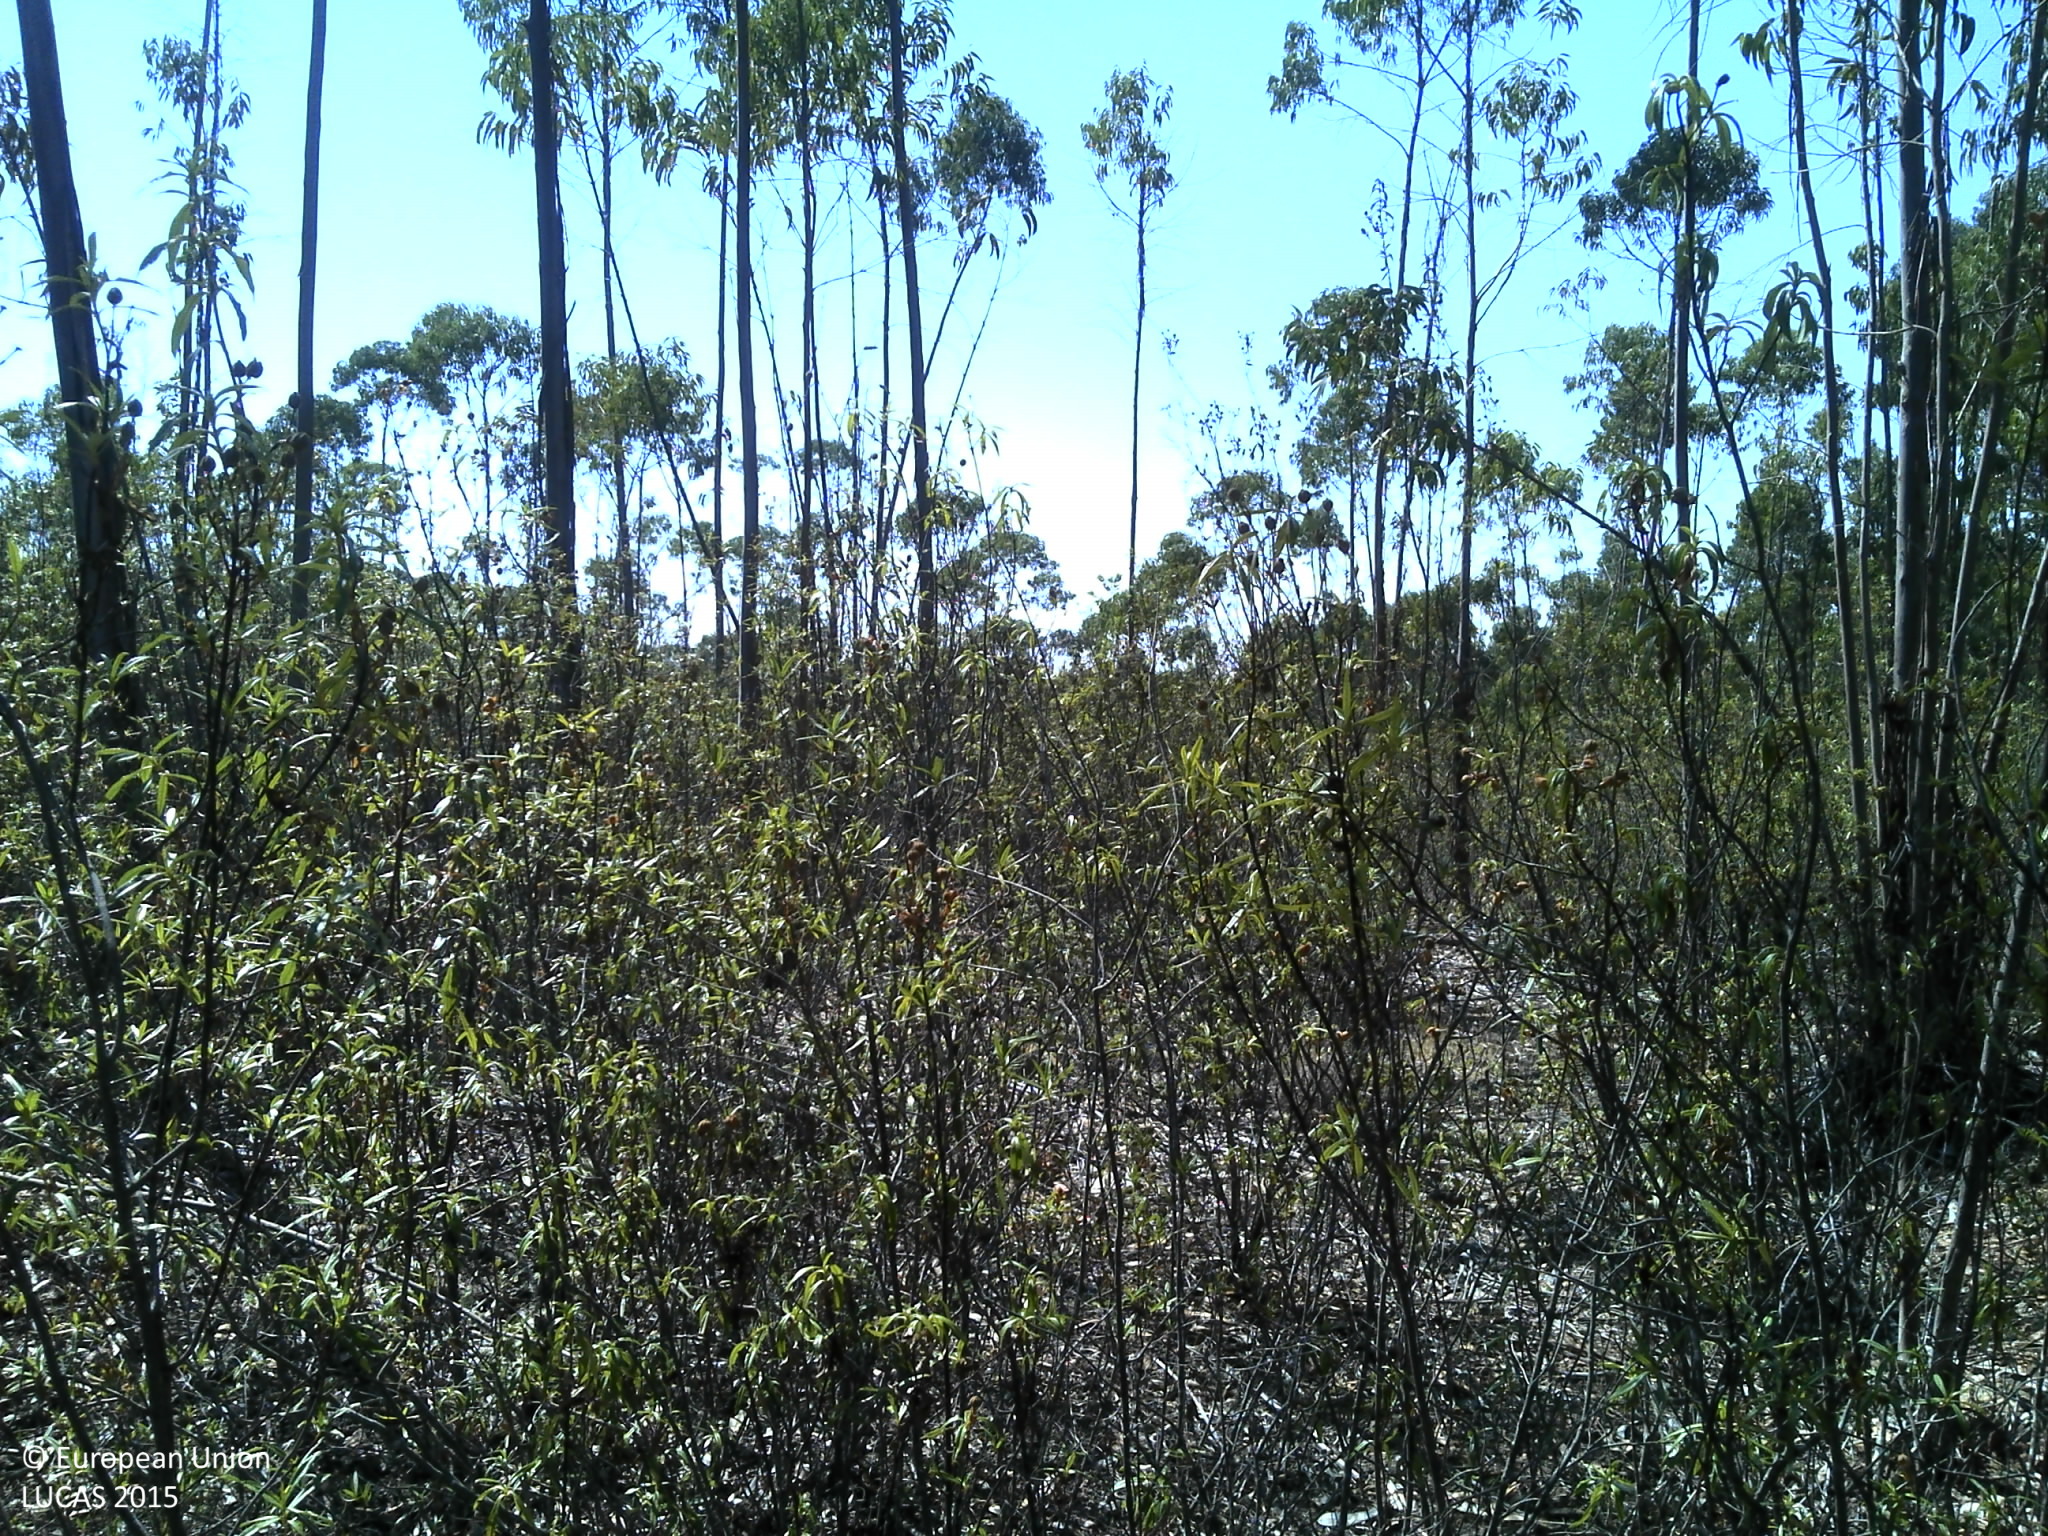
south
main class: Woodland
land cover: Broadleaved woodland
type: exotic forest
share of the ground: 10 - 25 %
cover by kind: shrubs 75 %, broadleaved forest trees 25 %
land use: Forestry
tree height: > 5 m
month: July
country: PT
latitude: 38.5914
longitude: -7.2812
